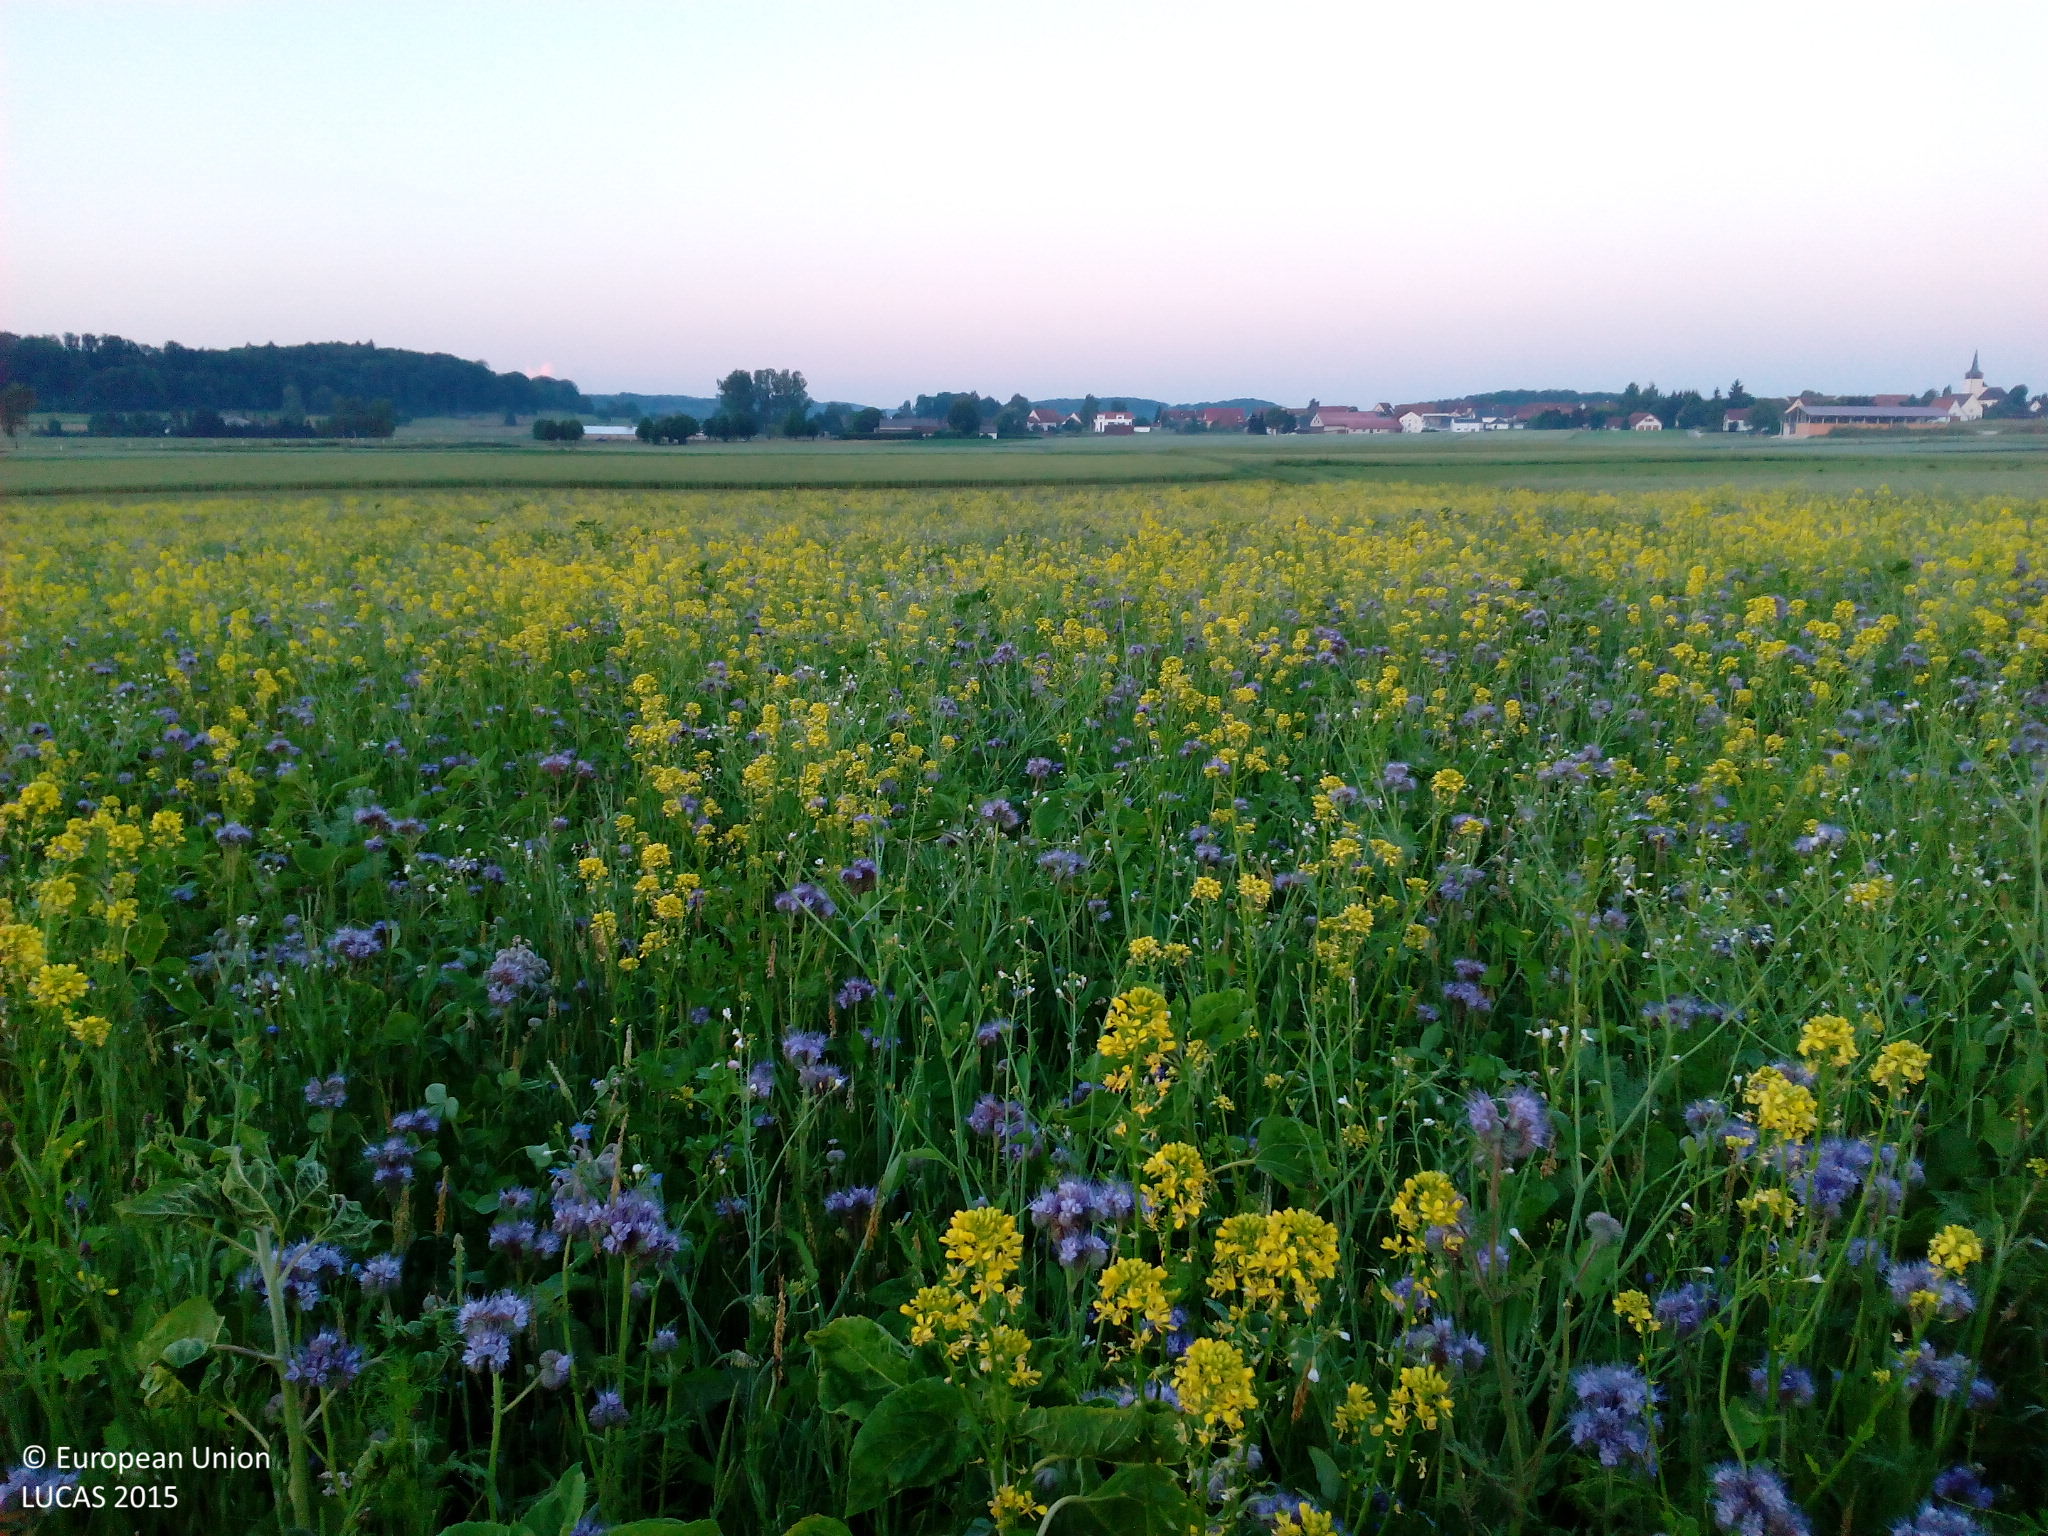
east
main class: Cropland
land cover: Other leguminous and mixtures for fodder
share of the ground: > 75 %
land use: Agriculture (excluding fallow land and kitchen gardens)
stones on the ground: < 10 %
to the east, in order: Other leguminous and mixtures for fodder; Paved roads, cycling and walking lanes; Spontaneously vegetated surfaces; Paved roads, cycling and walking lanes; Spontaneously vegetated surfaces; Paved roads, cycling and walking lanes; Grass margins; Temporary grasslands
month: July
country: DE
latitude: 48.3655
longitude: 9.3390
